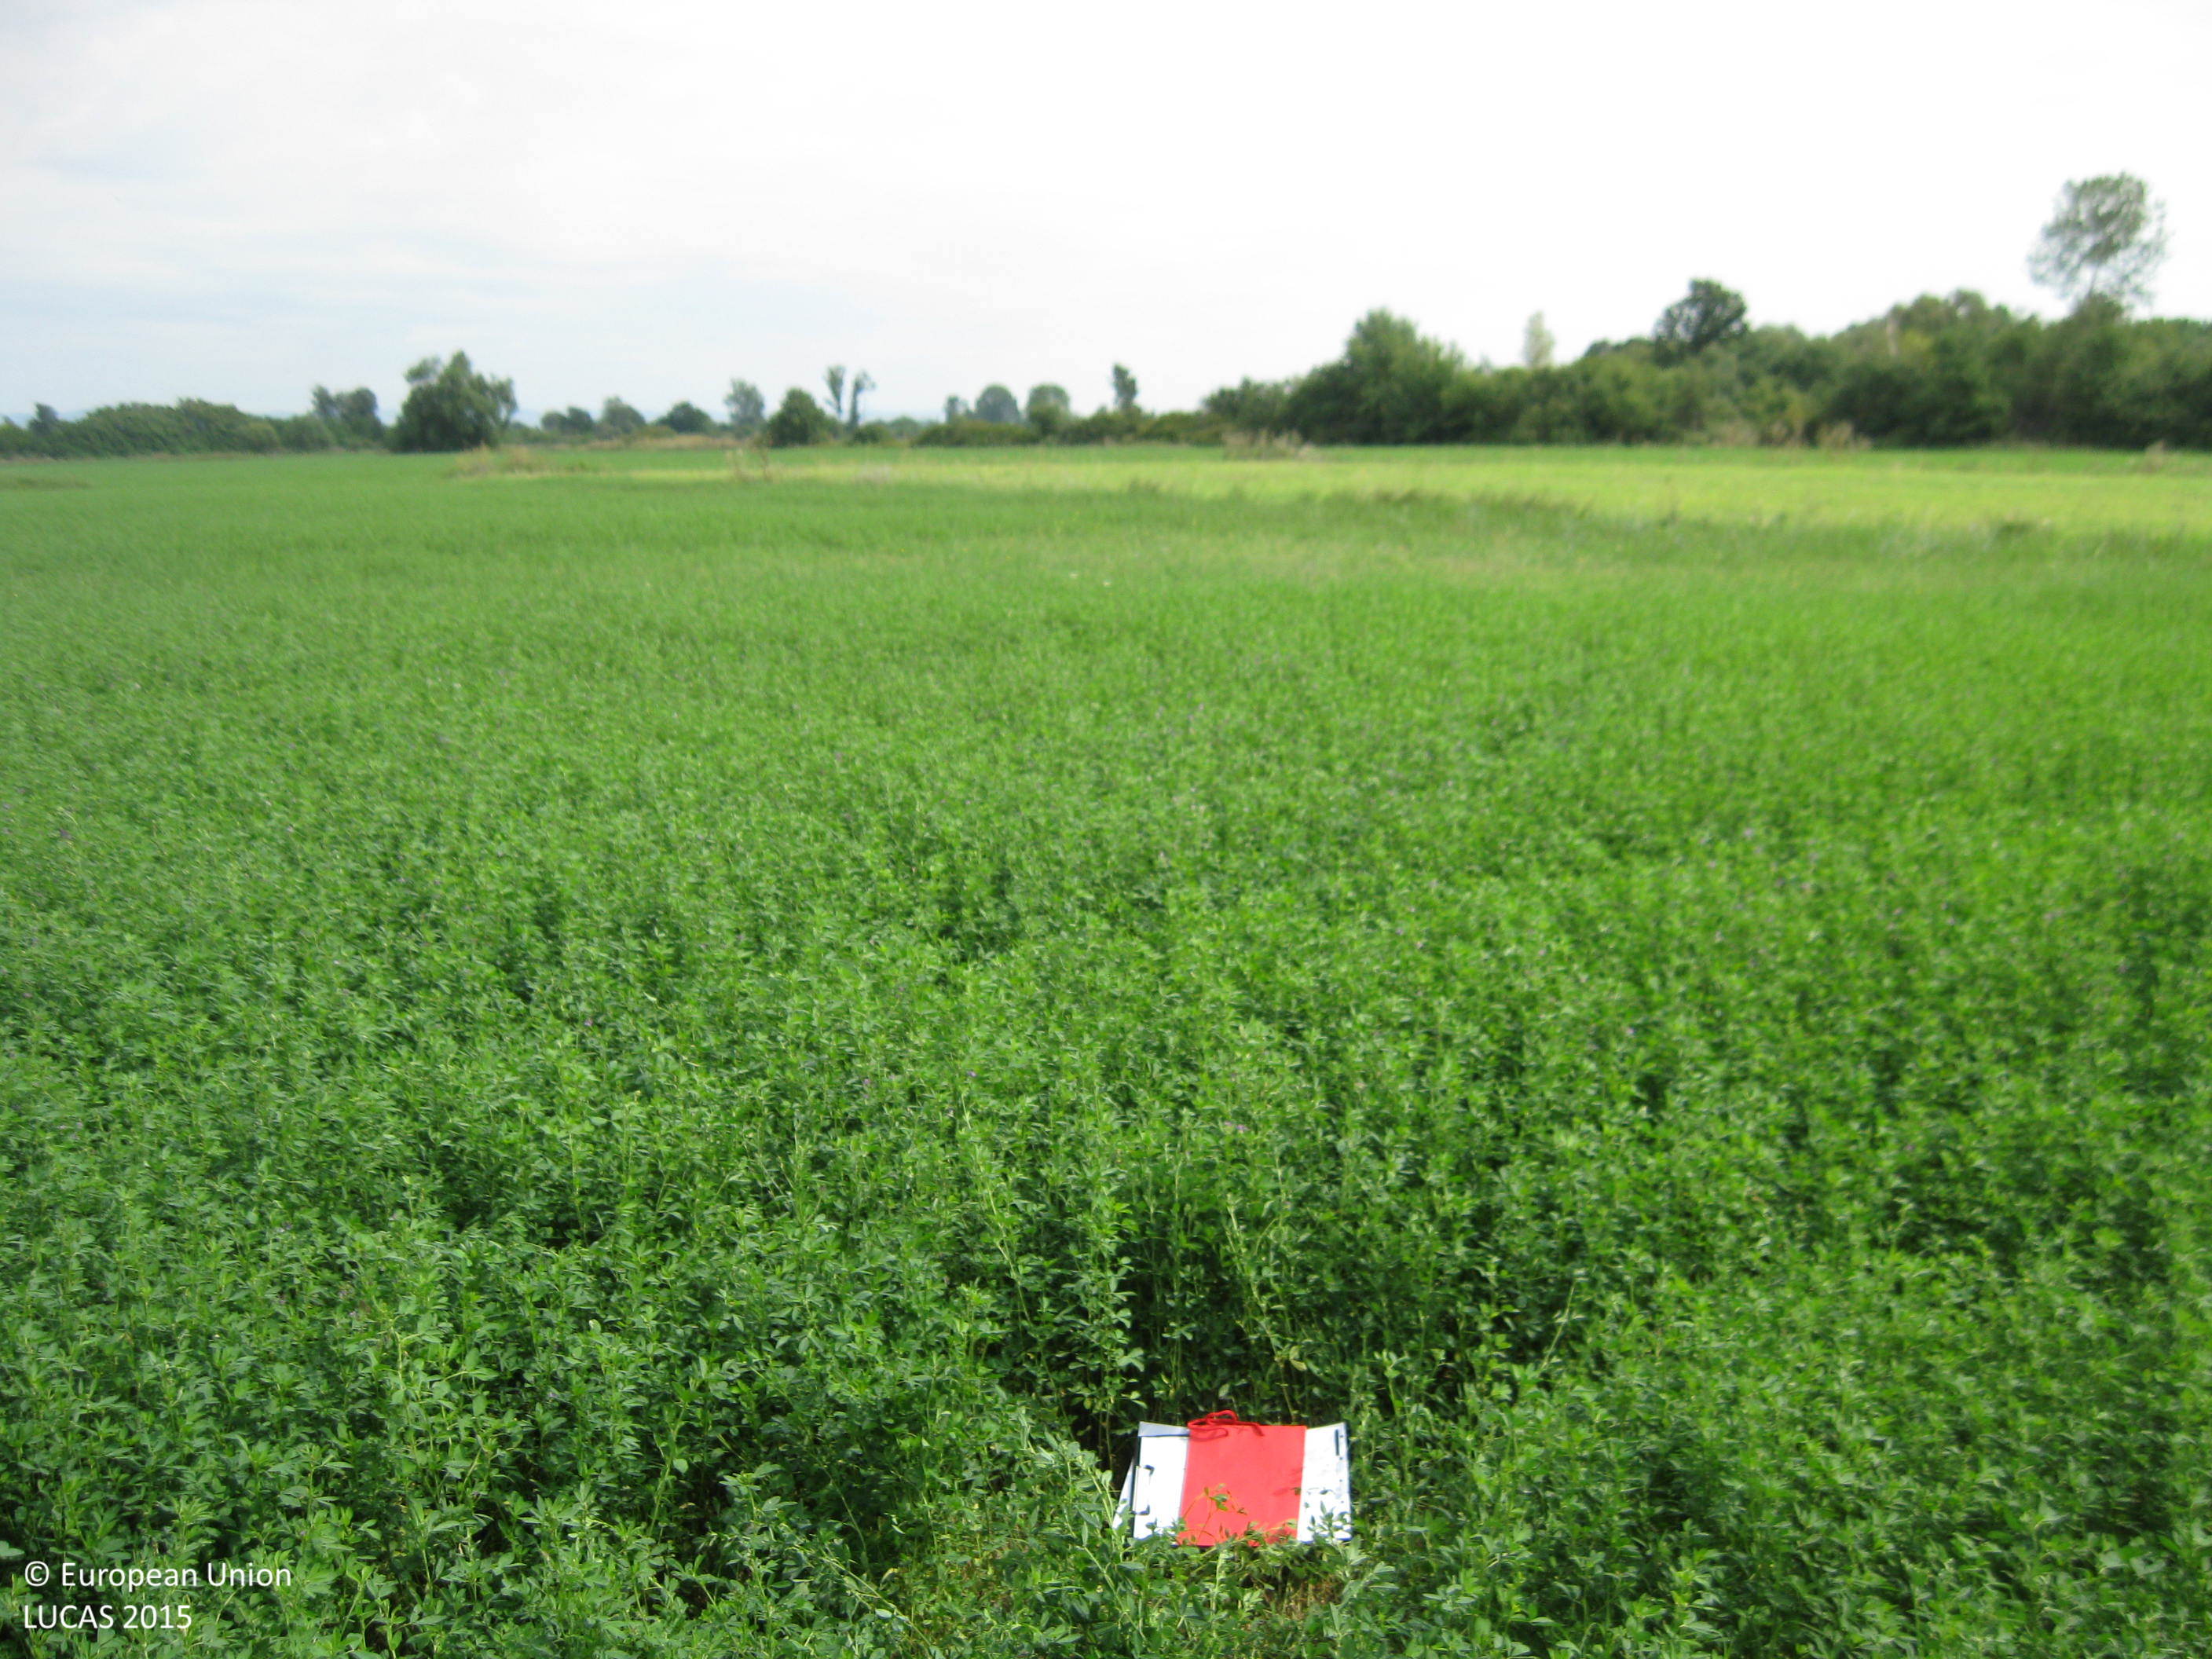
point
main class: Cropland
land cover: Lucerne
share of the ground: > 75 %
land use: Agriculture (excluding fallow land and kitchen gardens)
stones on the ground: < 10 %
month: September
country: BG
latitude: 42.1526
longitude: 25.1252
